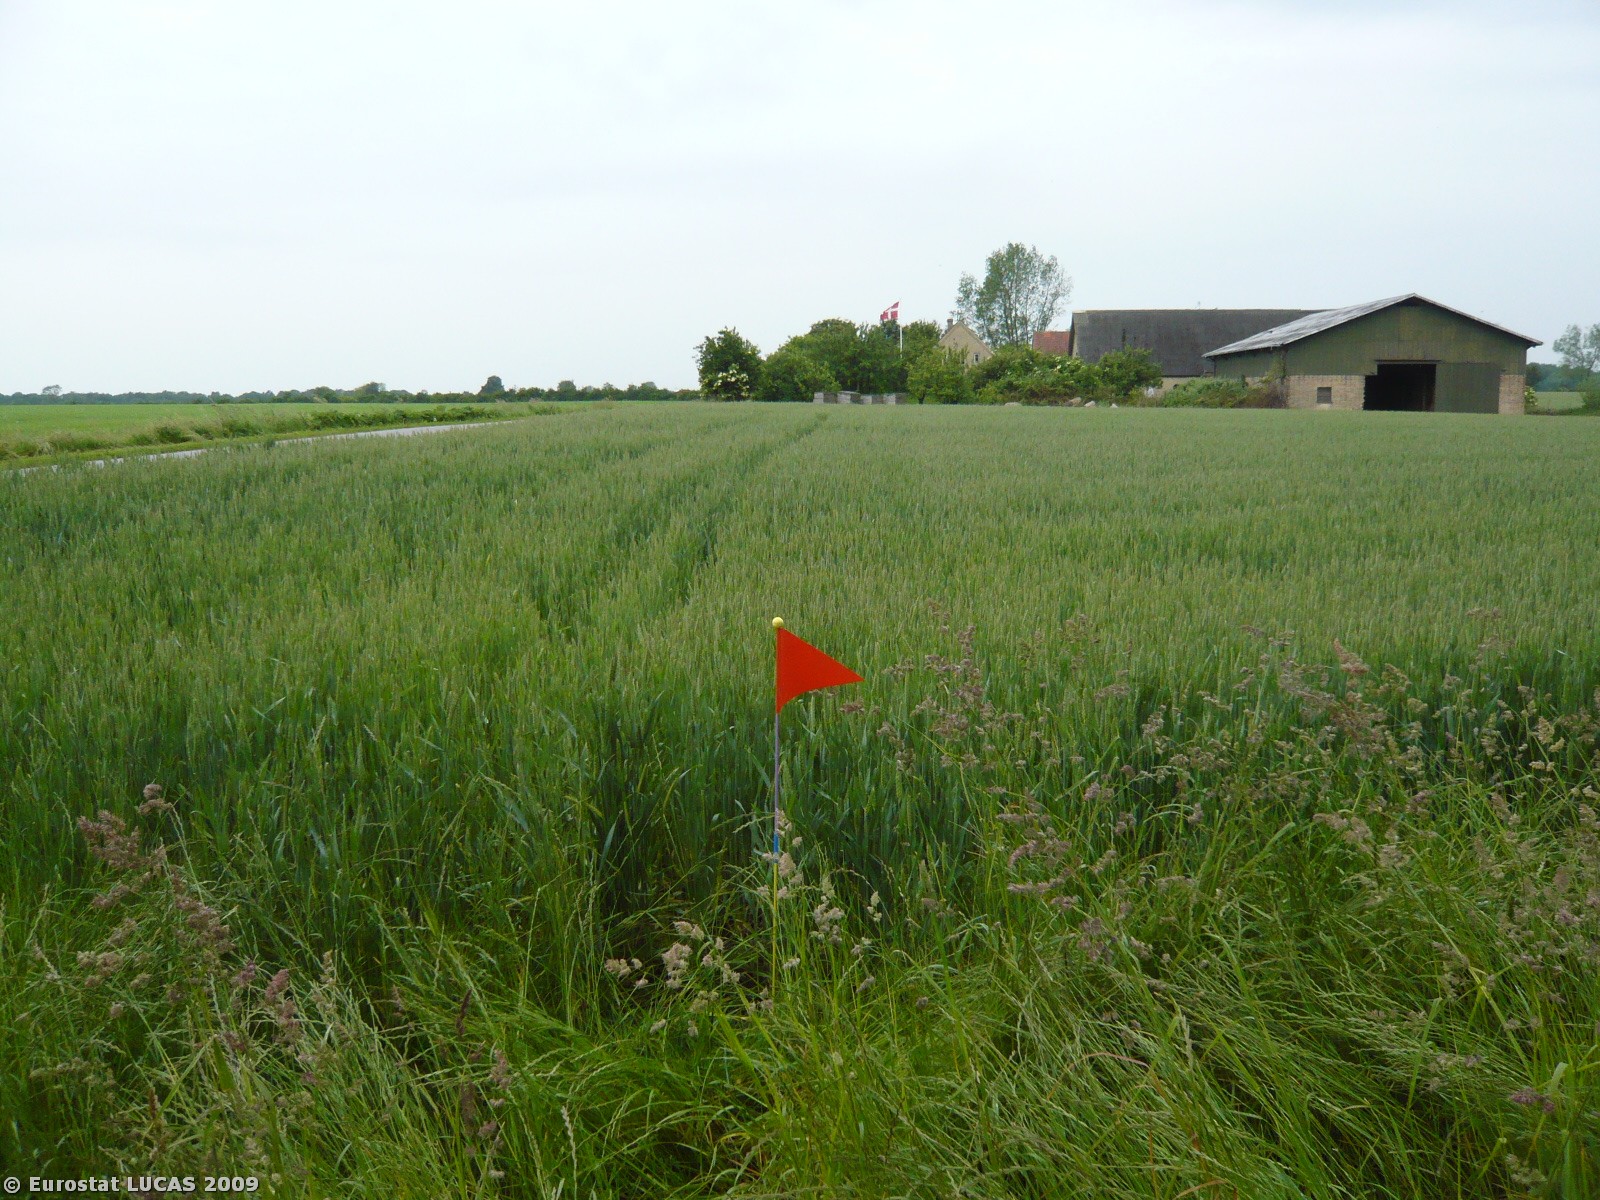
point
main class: Grassland
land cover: Grassland without tree/shrub cover
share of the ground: > 75 %
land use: Agriculture (excluding fallow land and kitchen gardens)
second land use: Road transport
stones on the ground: < 10 %
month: June
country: DK
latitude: 54.7555
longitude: 11.7547
